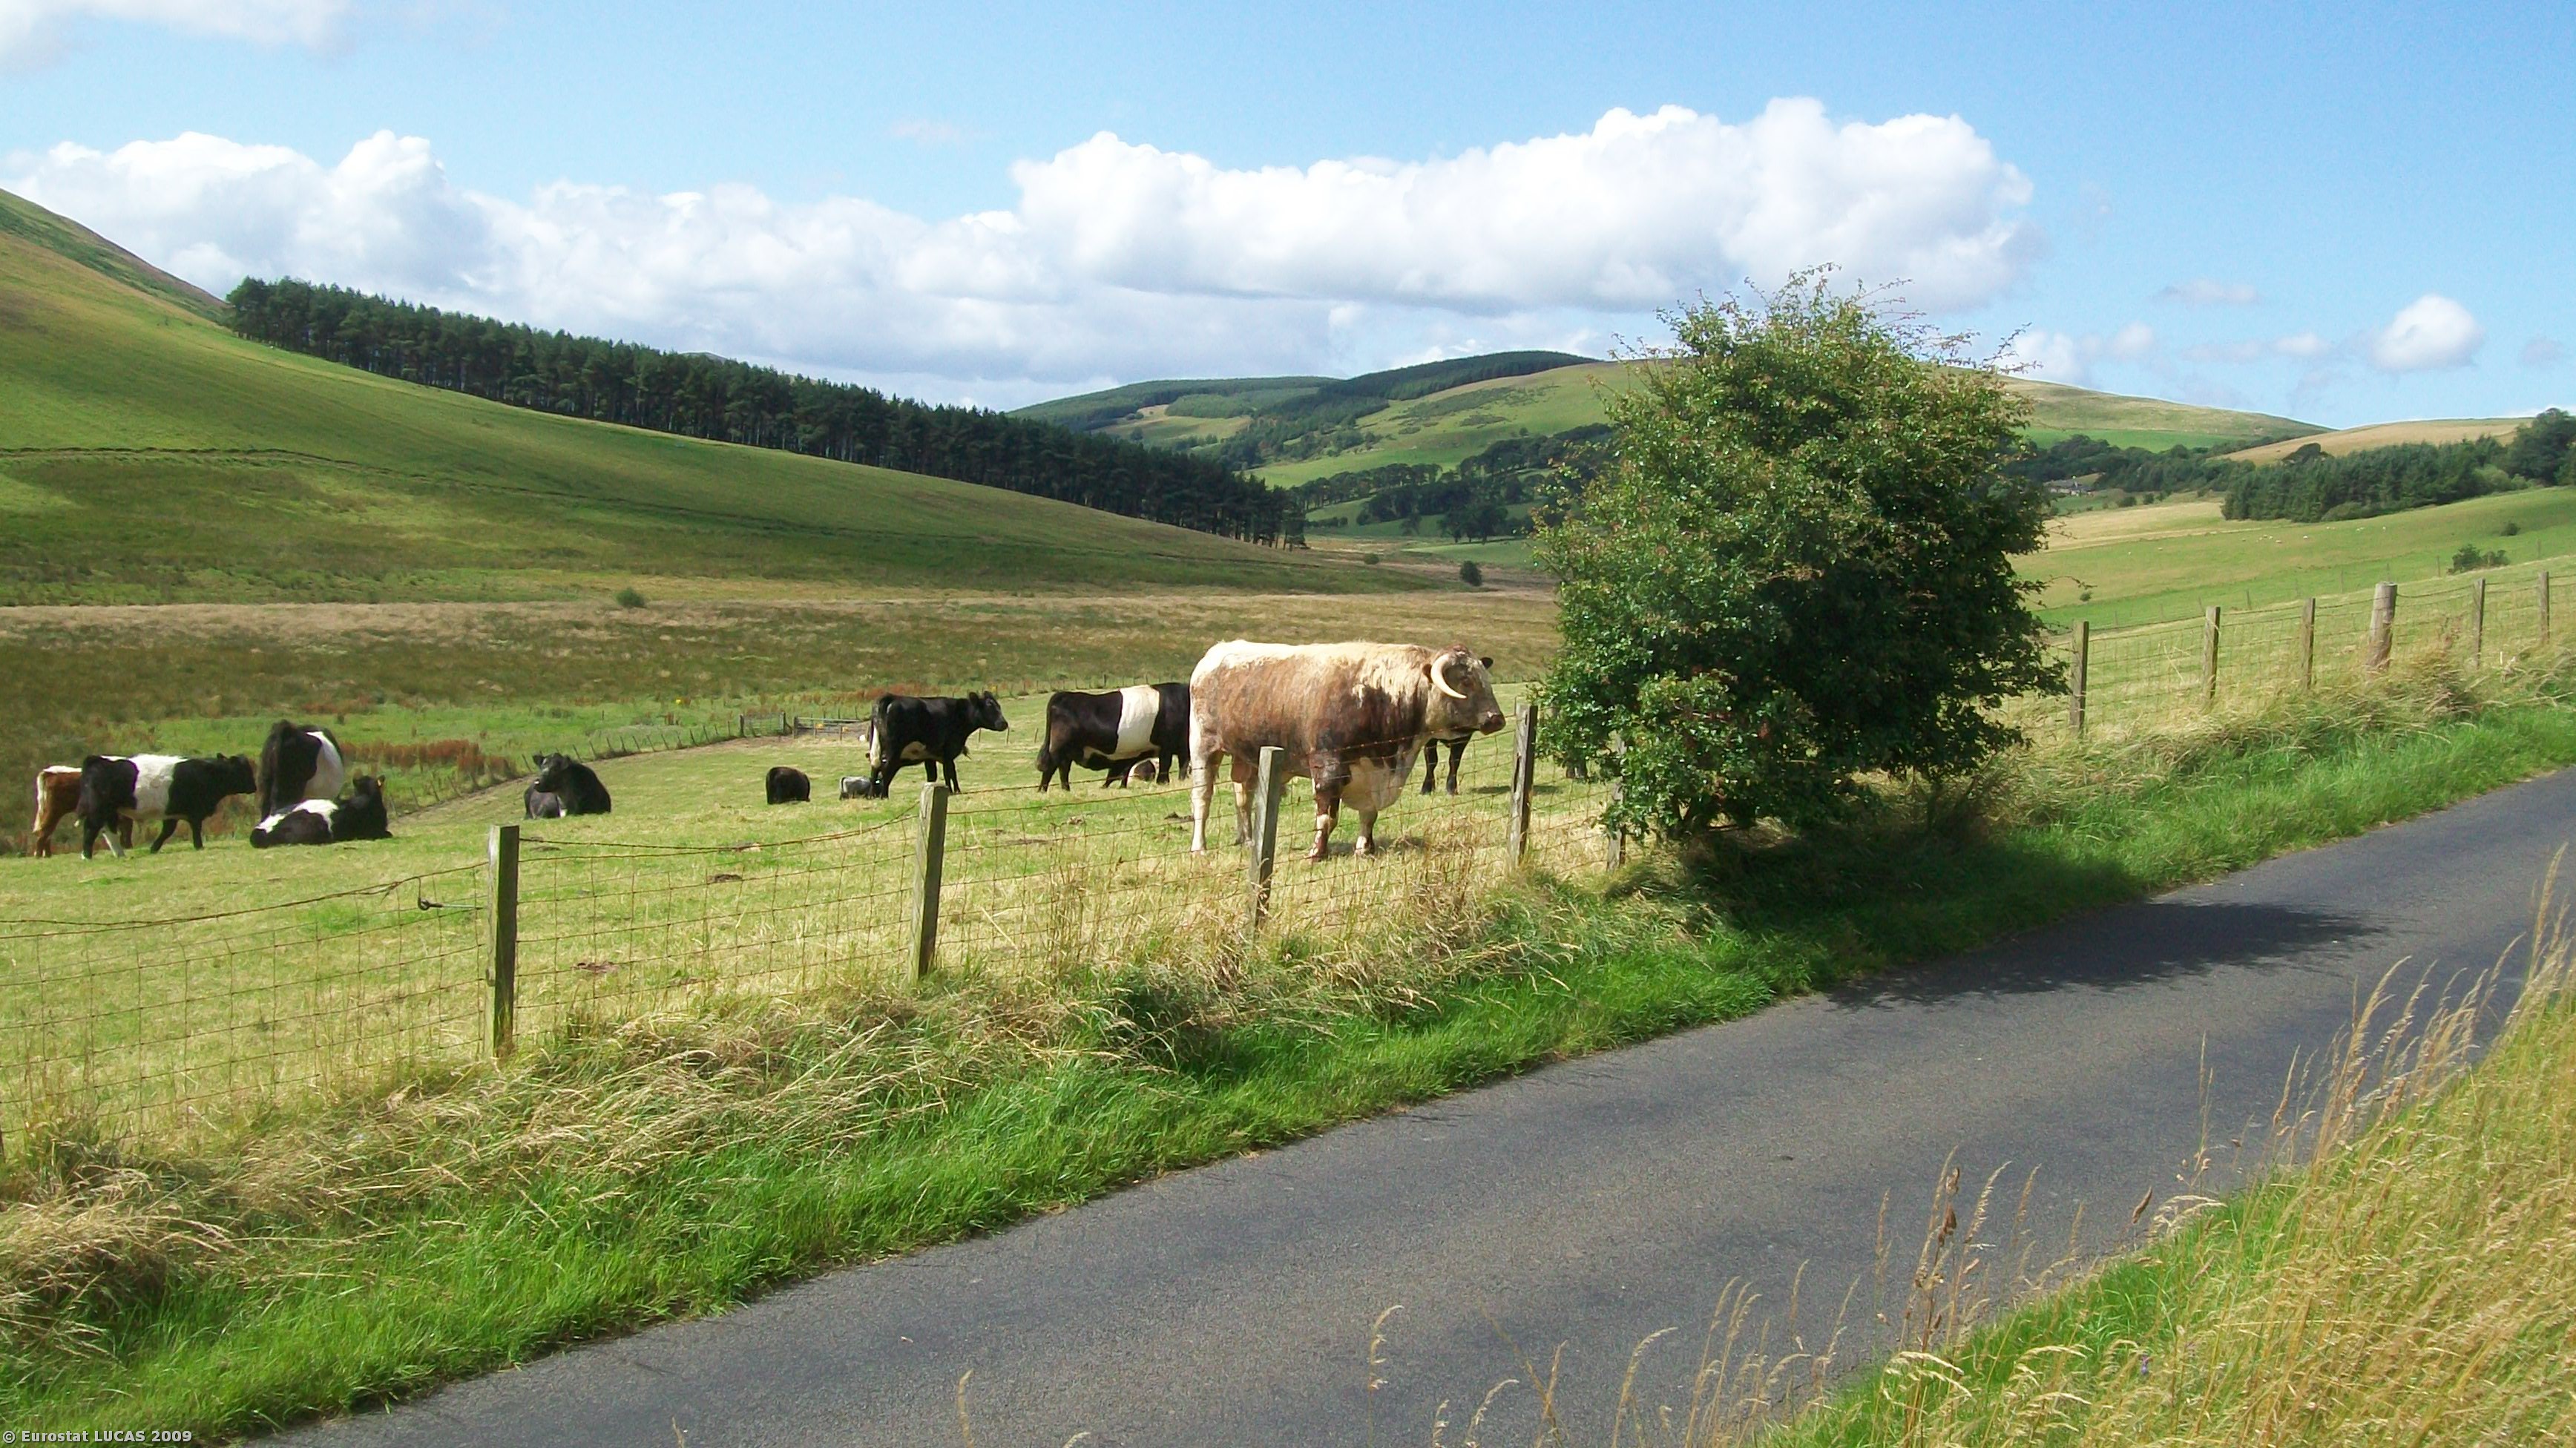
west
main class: Grassland
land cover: Grassland without tree/shrub cover
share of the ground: > 75 %
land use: Agriculture (excluding fallow land and kitchen gardens)
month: August
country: GB
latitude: 55.5989
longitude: -3.4891
